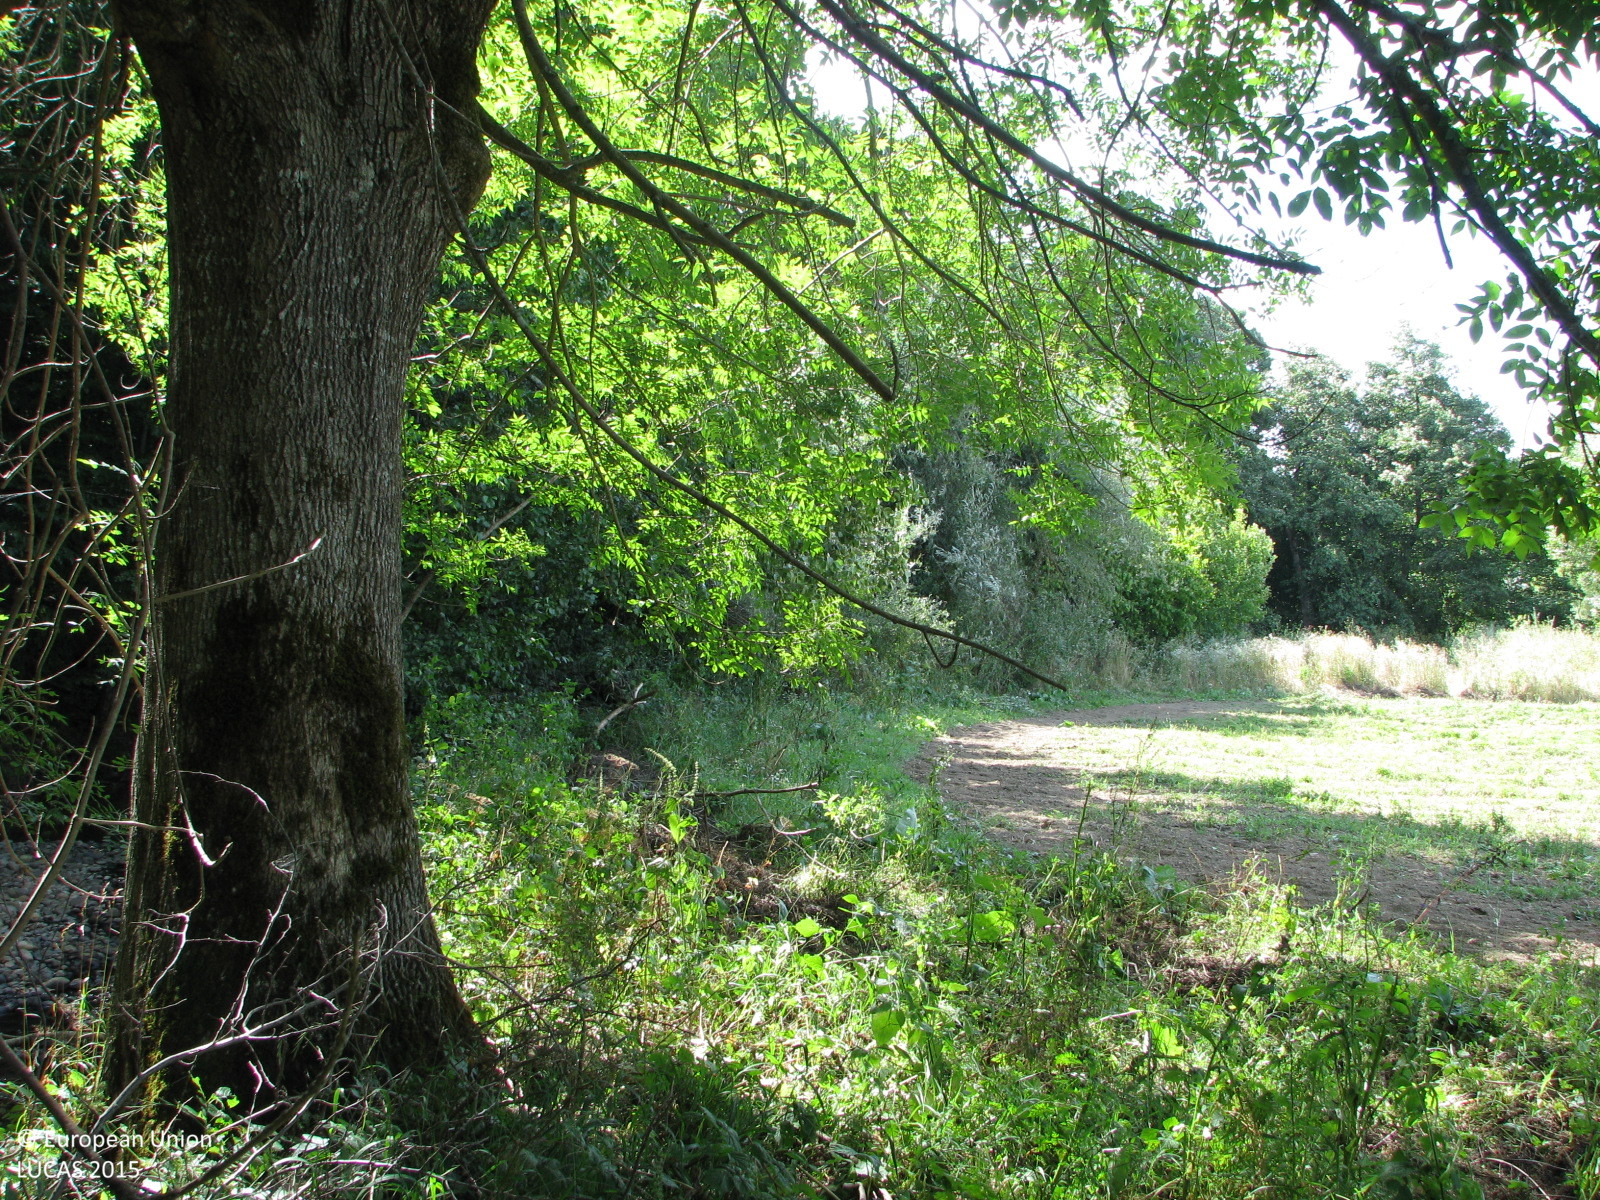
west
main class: Woodland
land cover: Broadleaved woodland
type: beech forest
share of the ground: > 75 %
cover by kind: broadleaved forest trees 100 %
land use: Forestry
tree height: > 5 m
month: August
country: BG
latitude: 42.9164
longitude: 26.2245
